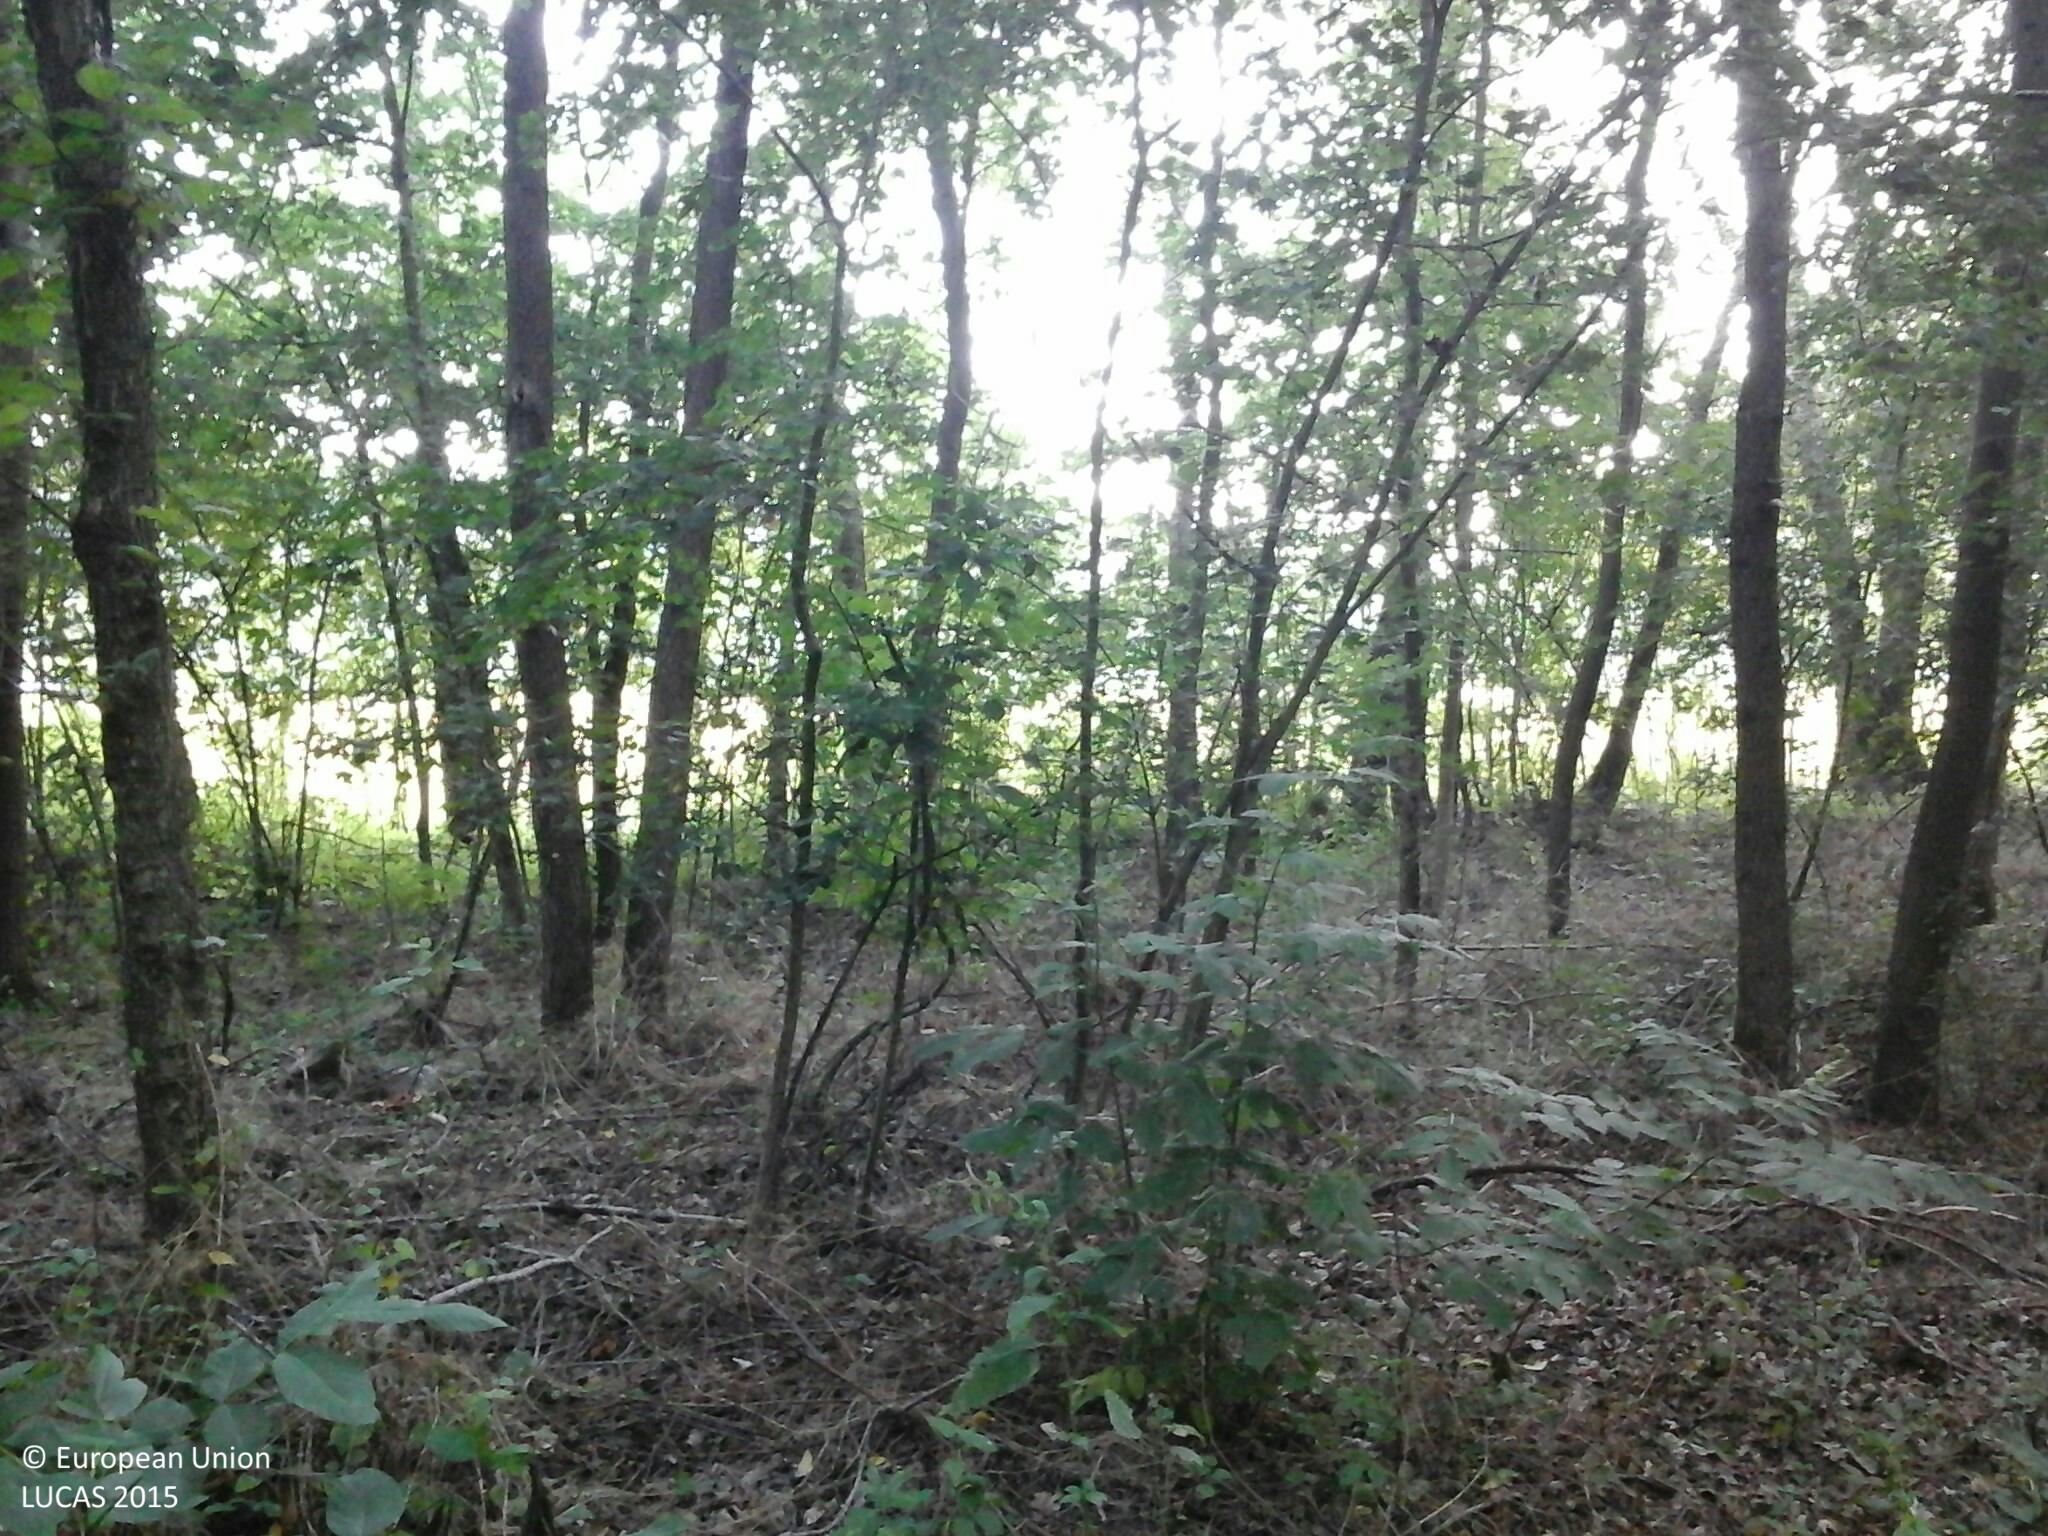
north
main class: Woodland
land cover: Broadleaved woodland
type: exotic forest
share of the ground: > 75 %
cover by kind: broadleaved forest trees 95 %, herbaceous plants 5 %
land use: Forestry
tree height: > 5 m
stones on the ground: < 10 %
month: July
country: HU
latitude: 48.1649
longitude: 22.3334
